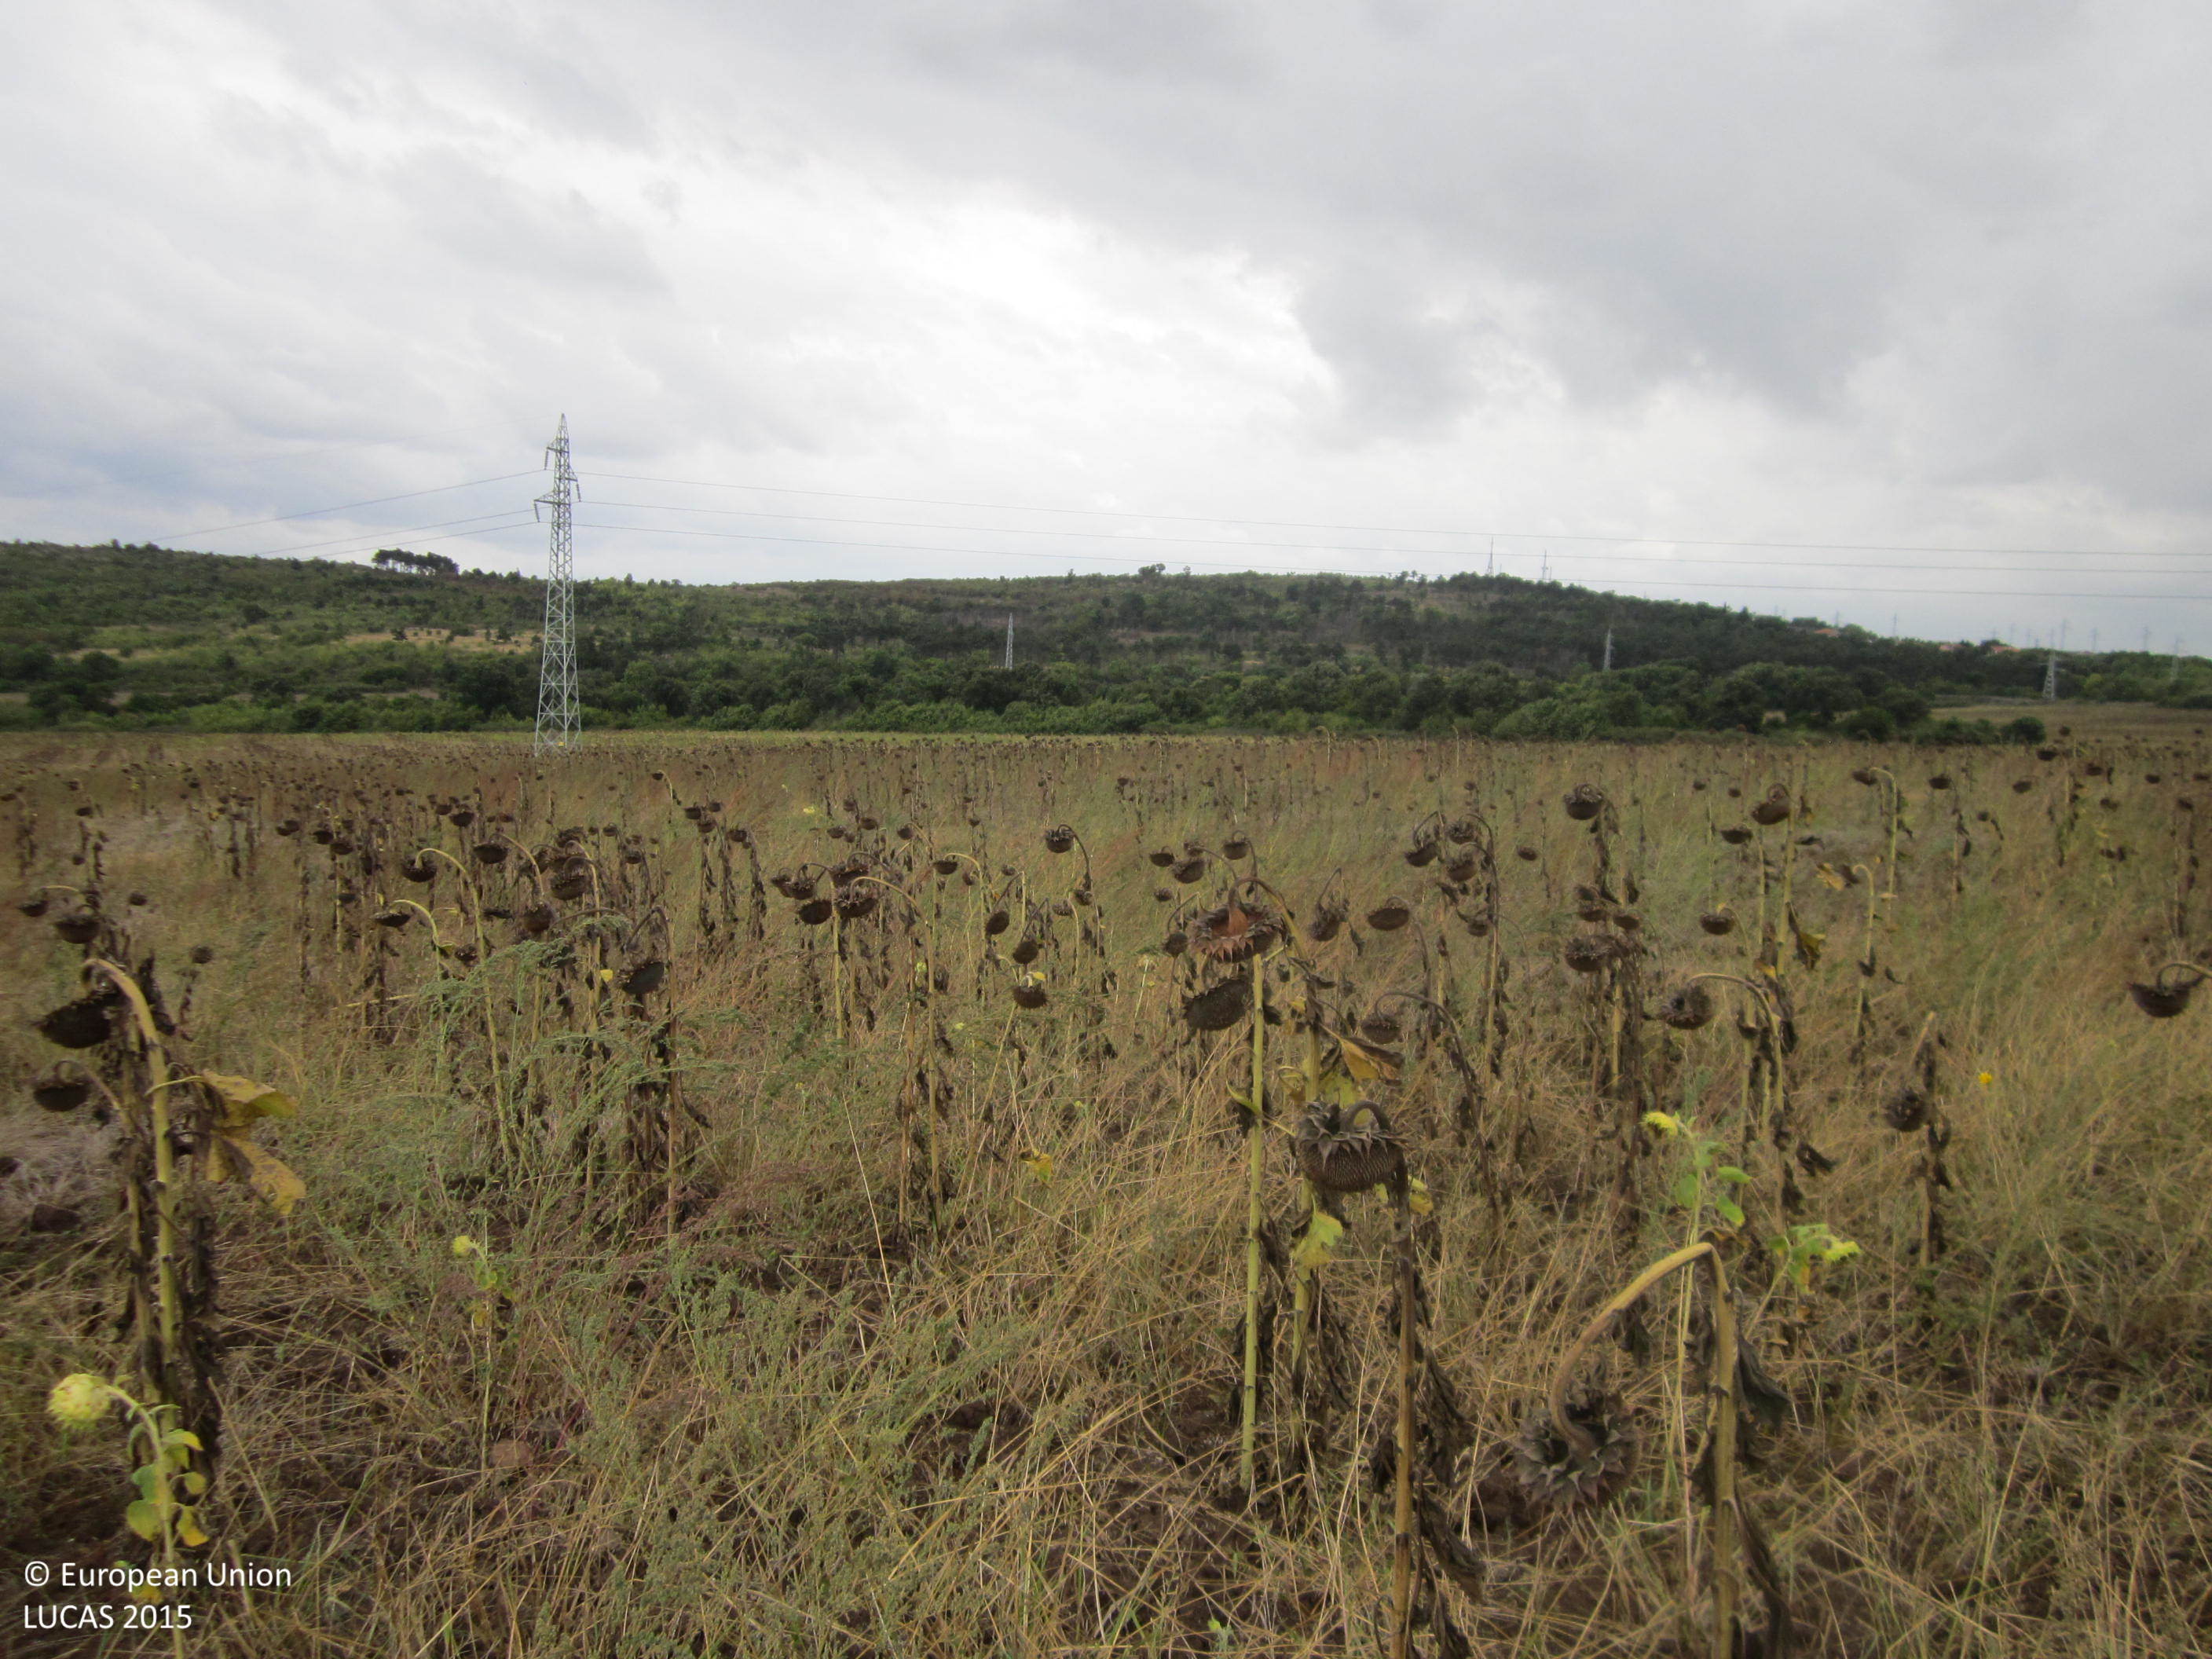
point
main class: Cropland
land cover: Sunflower
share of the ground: 25 - 50 %
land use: Agriculture (excluding fallow land and kitchen gardens)
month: September
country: BG
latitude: 42.4796
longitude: 27.4007
